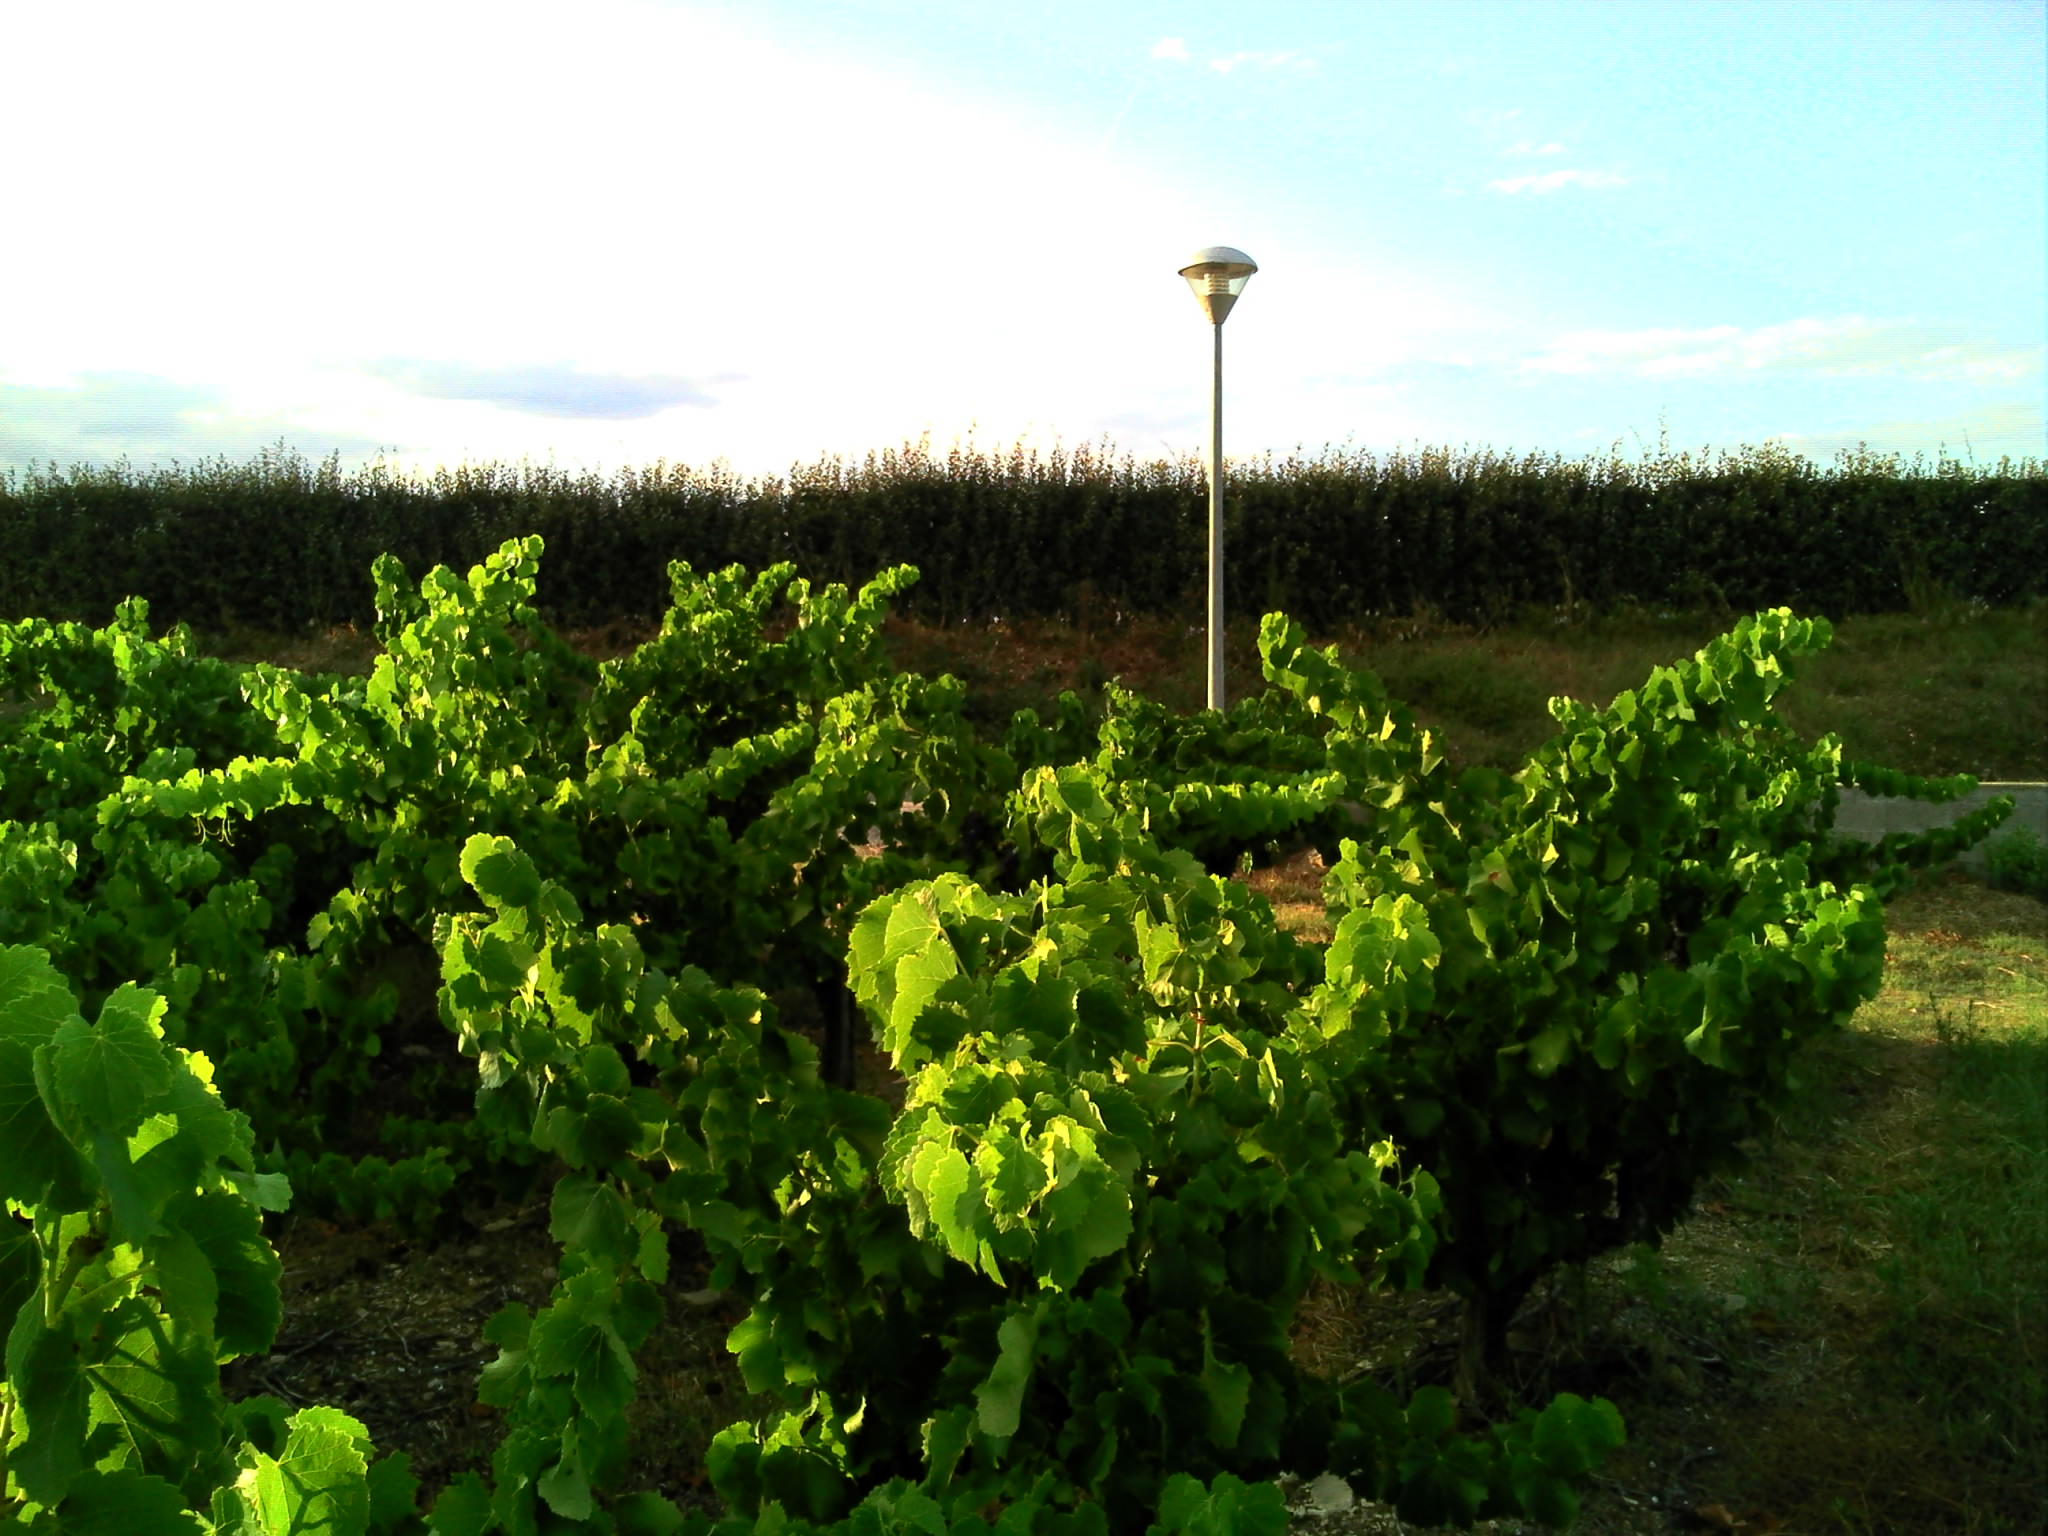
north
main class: Cropland
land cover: Vineyards
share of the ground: 50 - 75 %
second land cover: Spontaneously vegetated surfaces
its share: 25 - 50 %
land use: Agriculture (excluding fallow land and kitchen gardens)
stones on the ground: < 10 %
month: August
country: FR
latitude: 44.2300
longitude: 4.6368
